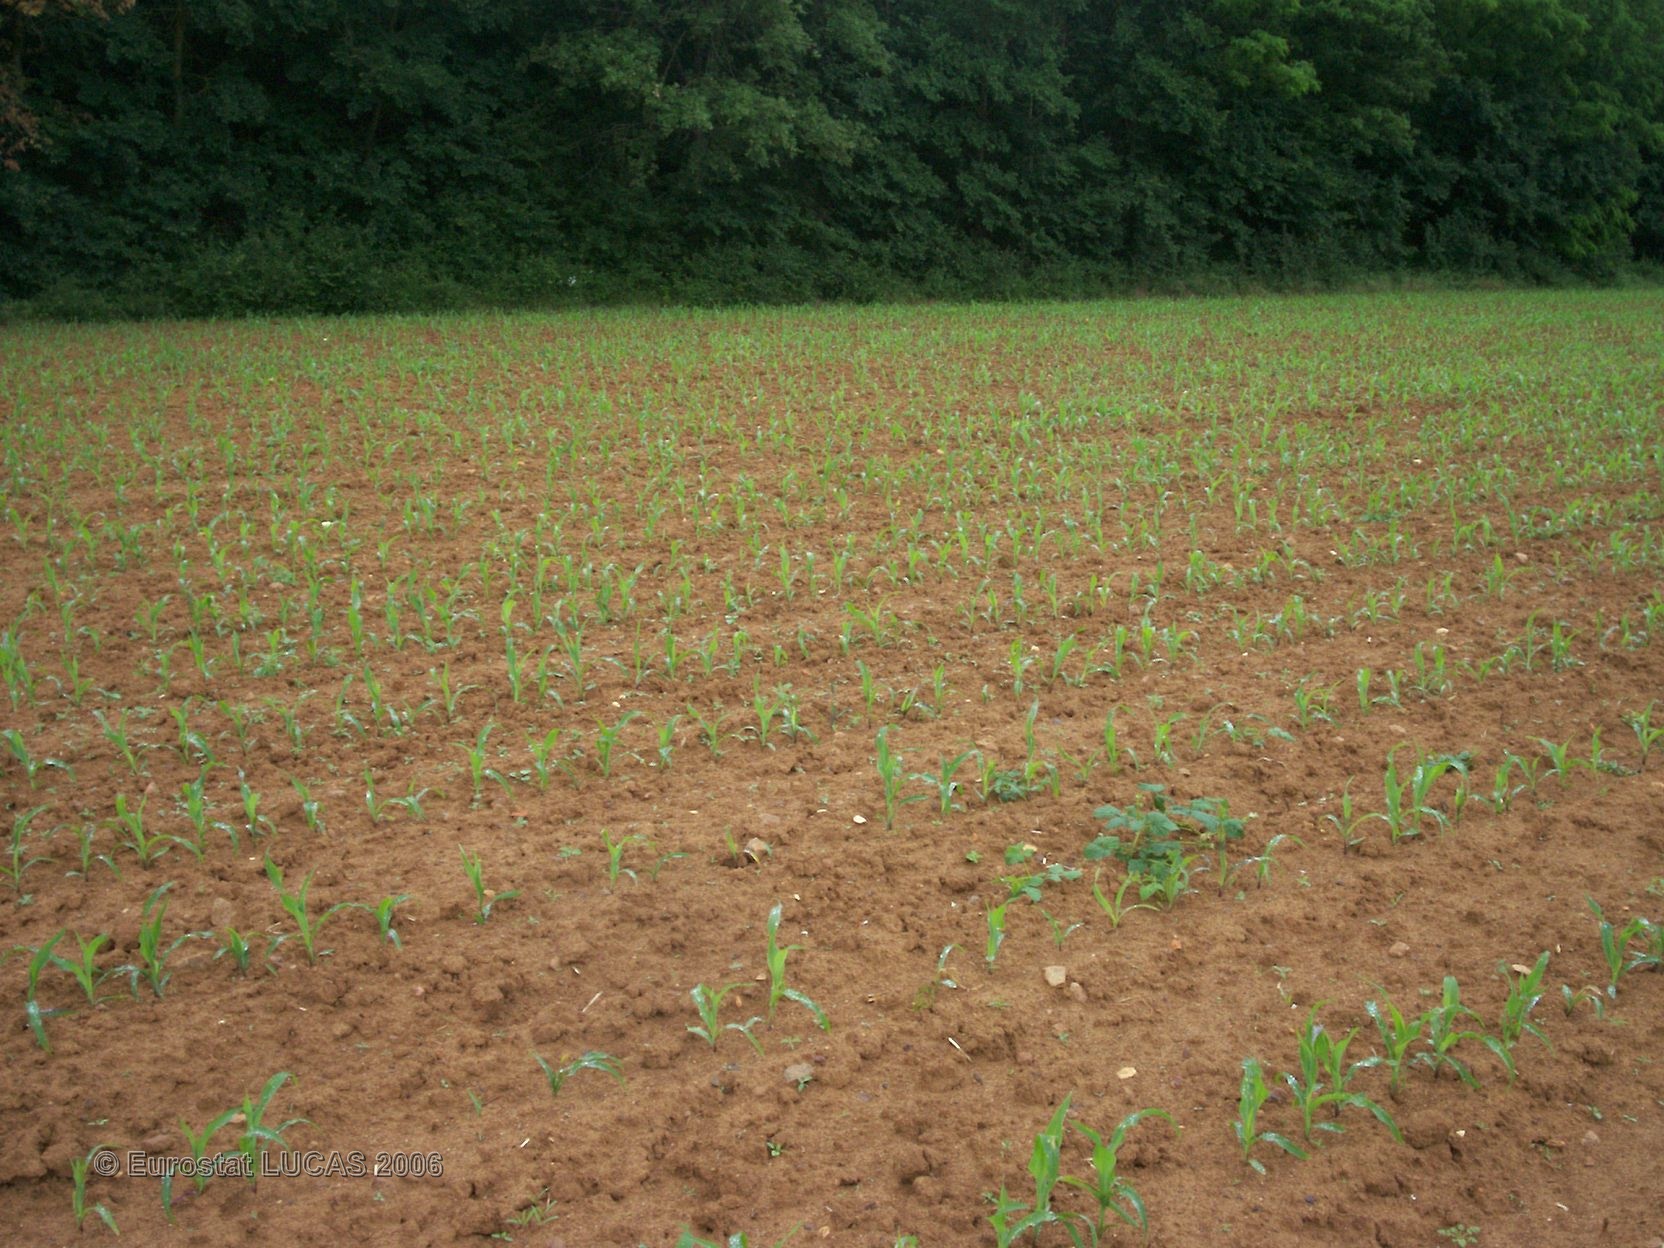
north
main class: Cropland
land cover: Maize
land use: Agriculture (excluding fallow land and kitchen gardens)
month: May
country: FR
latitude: 46.6845
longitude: 0.4501
